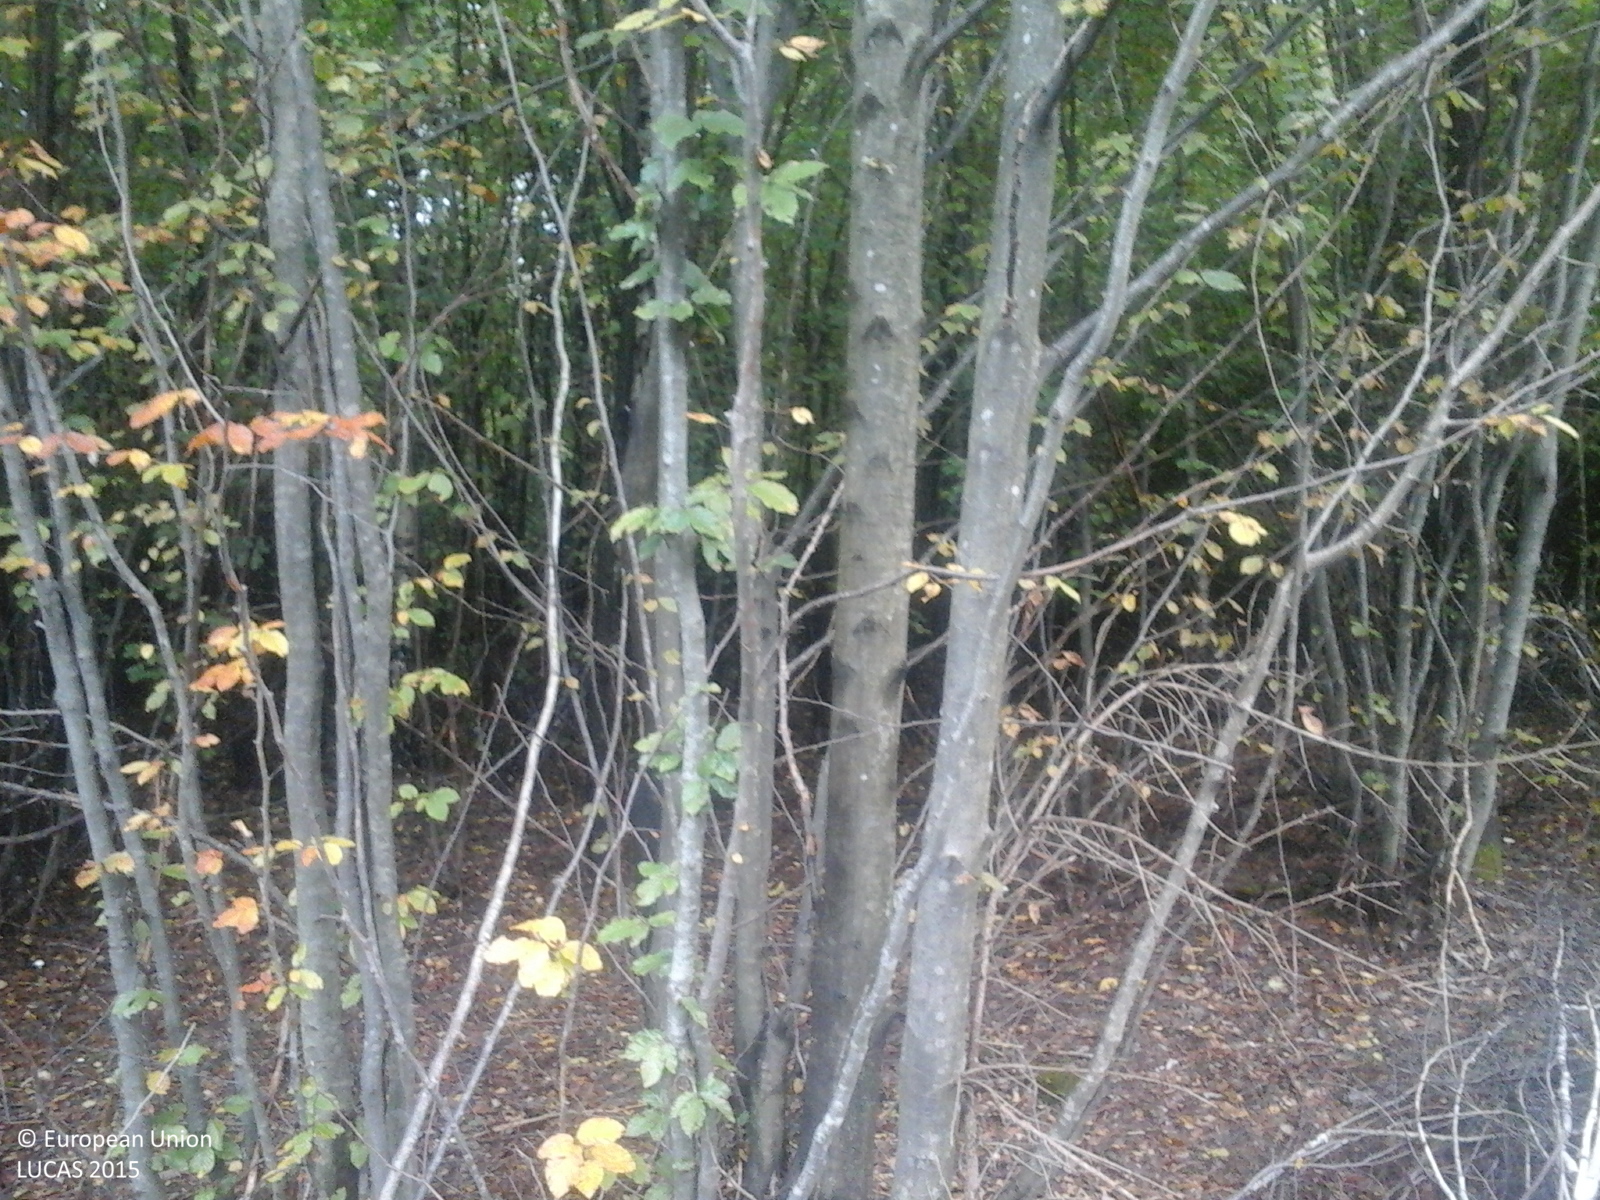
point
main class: Woodland
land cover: Broadleaved woodland
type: beech forest
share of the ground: > 75 %
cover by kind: broadleaved forest trees 100 %
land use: Forestry
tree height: > 5 m
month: October
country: RO
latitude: 45.7035
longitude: 24.7672
